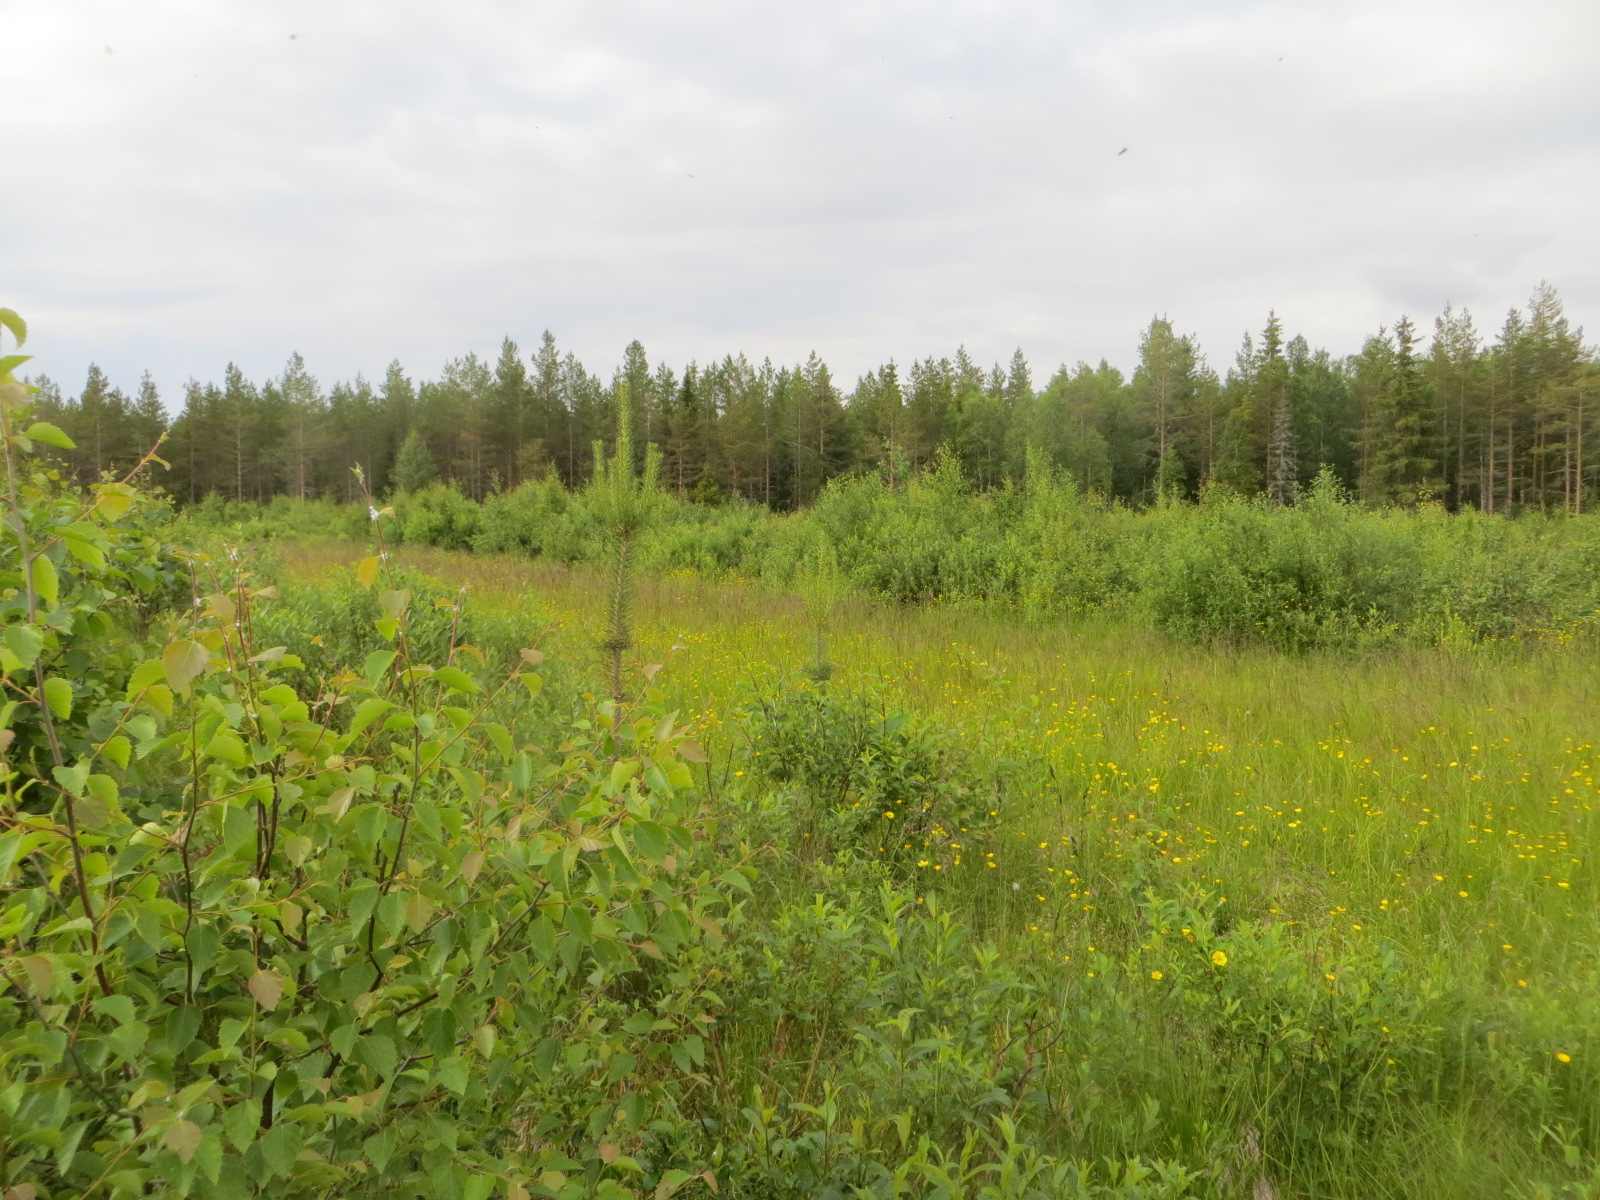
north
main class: Woodland
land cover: Broadleaved woodland
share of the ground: > 75 %
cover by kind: broadleaved forest trees 95 %, herbaceous plants 5 %
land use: Abandoned areas
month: July
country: FI
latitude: 65.9792
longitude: 26.0897
